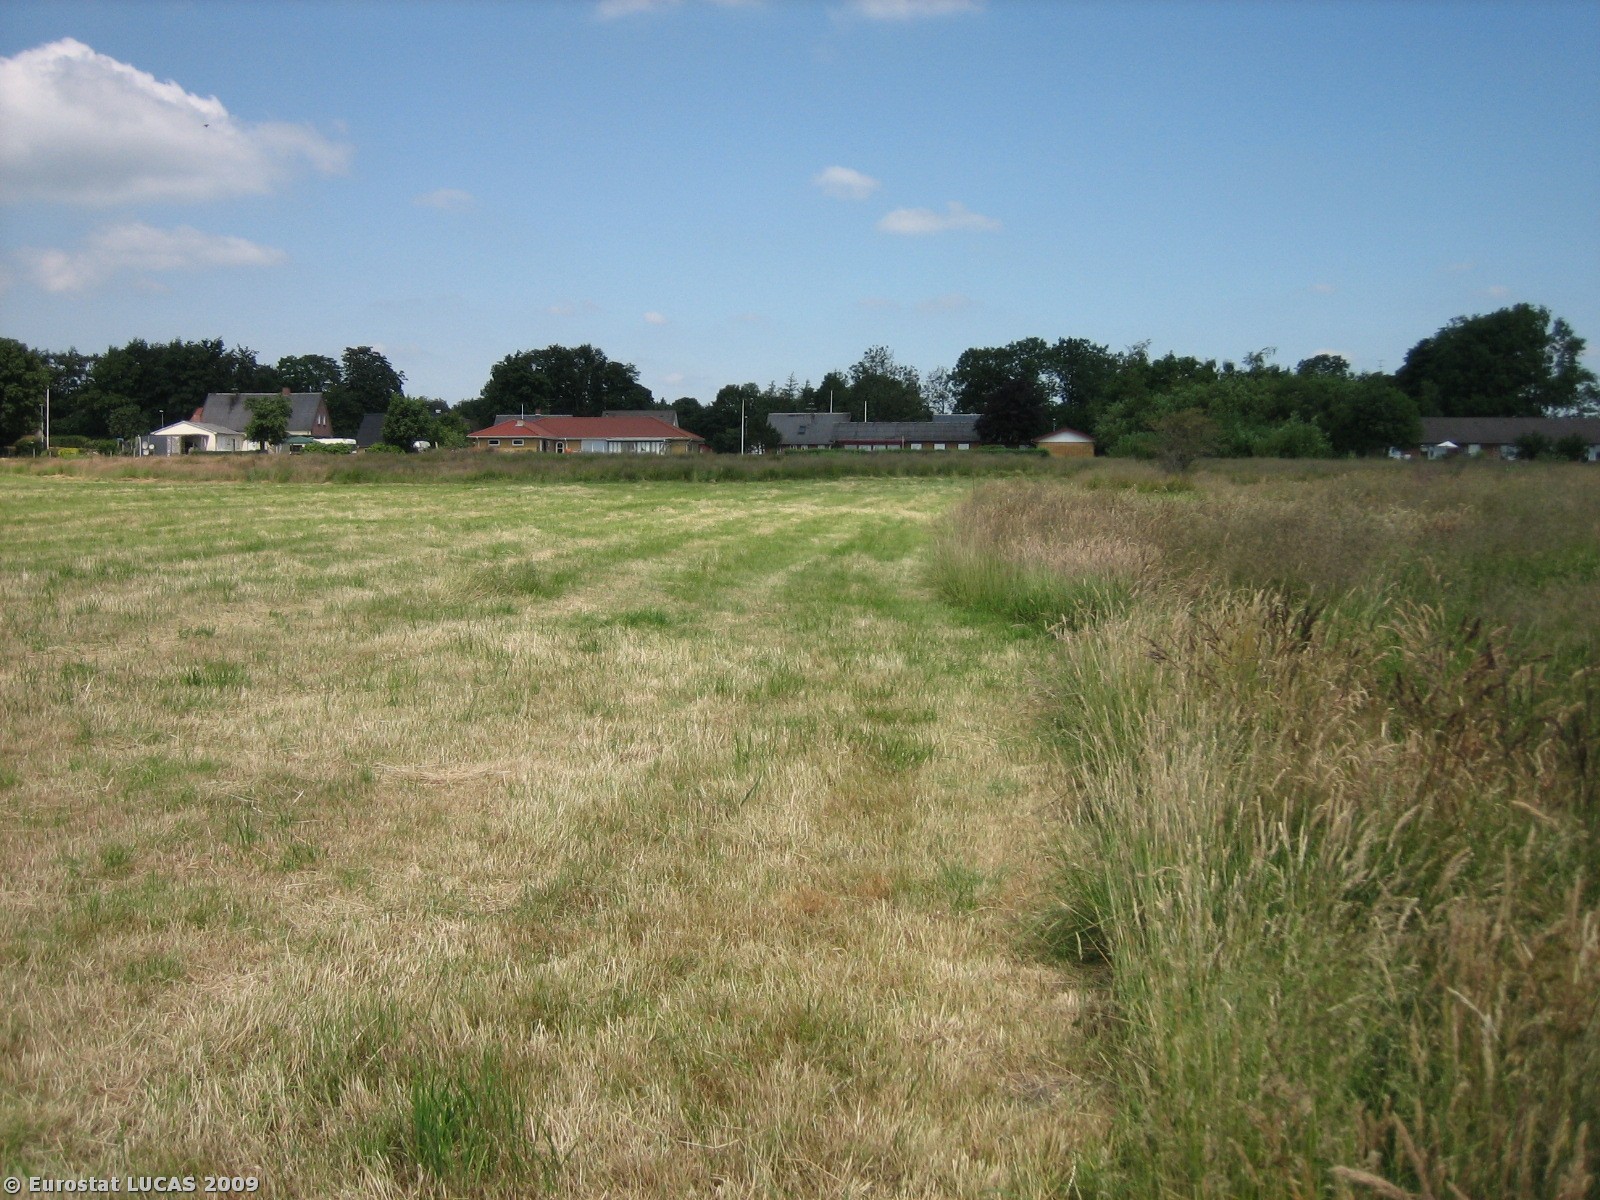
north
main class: Grassland
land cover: Grassland without tree/shrub cover
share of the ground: > 75 %
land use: Unused
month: July
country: DK
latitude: 55.4458
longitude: 8.8786
